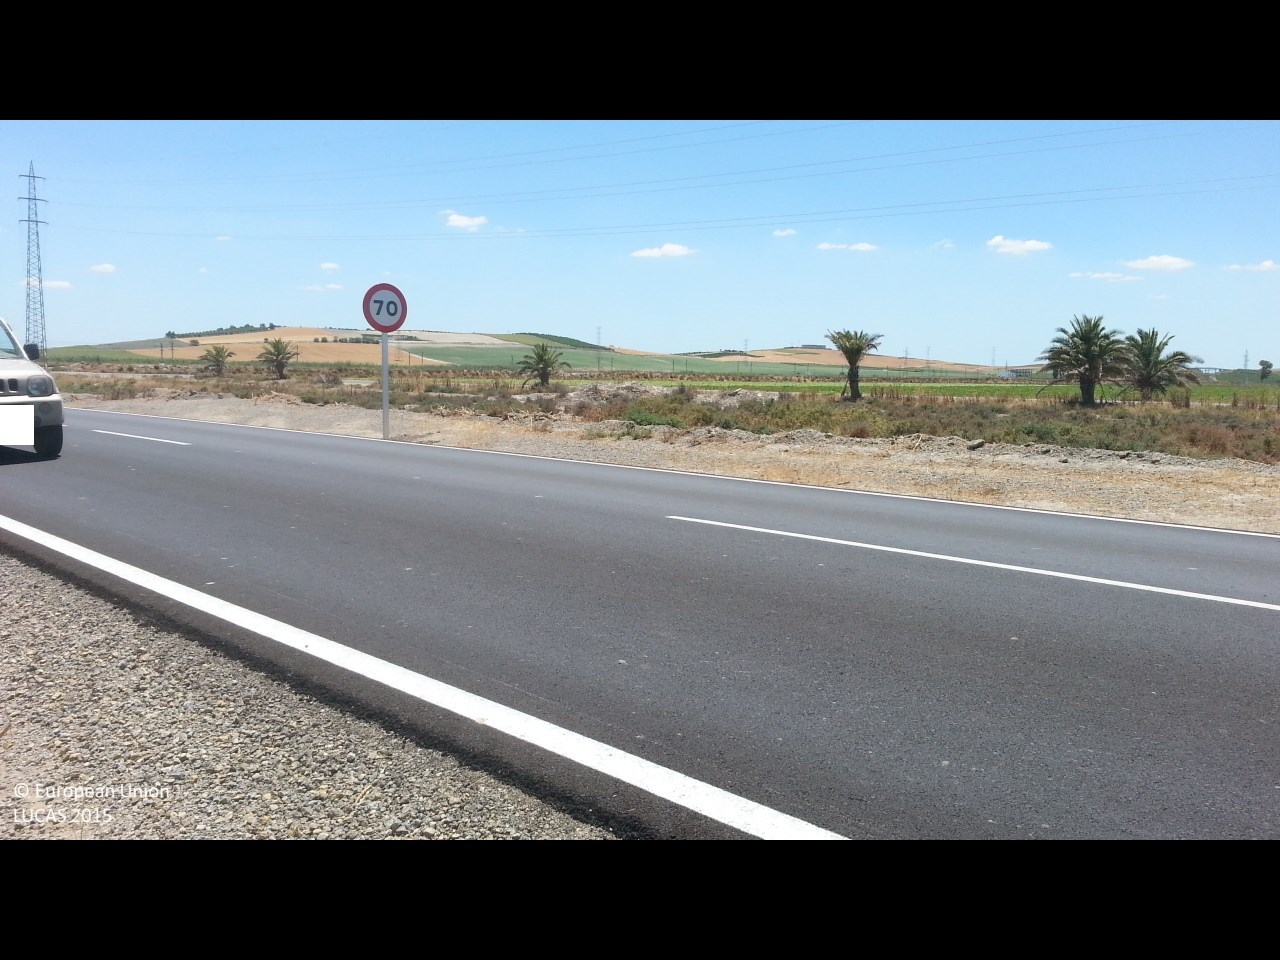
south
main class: Cropland
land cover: Maize
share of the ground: > 75 %
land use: Agriculture (excluding fallow land and kitchen gardens)
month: June
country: ES
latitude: 36.9620
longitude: -6.0663
